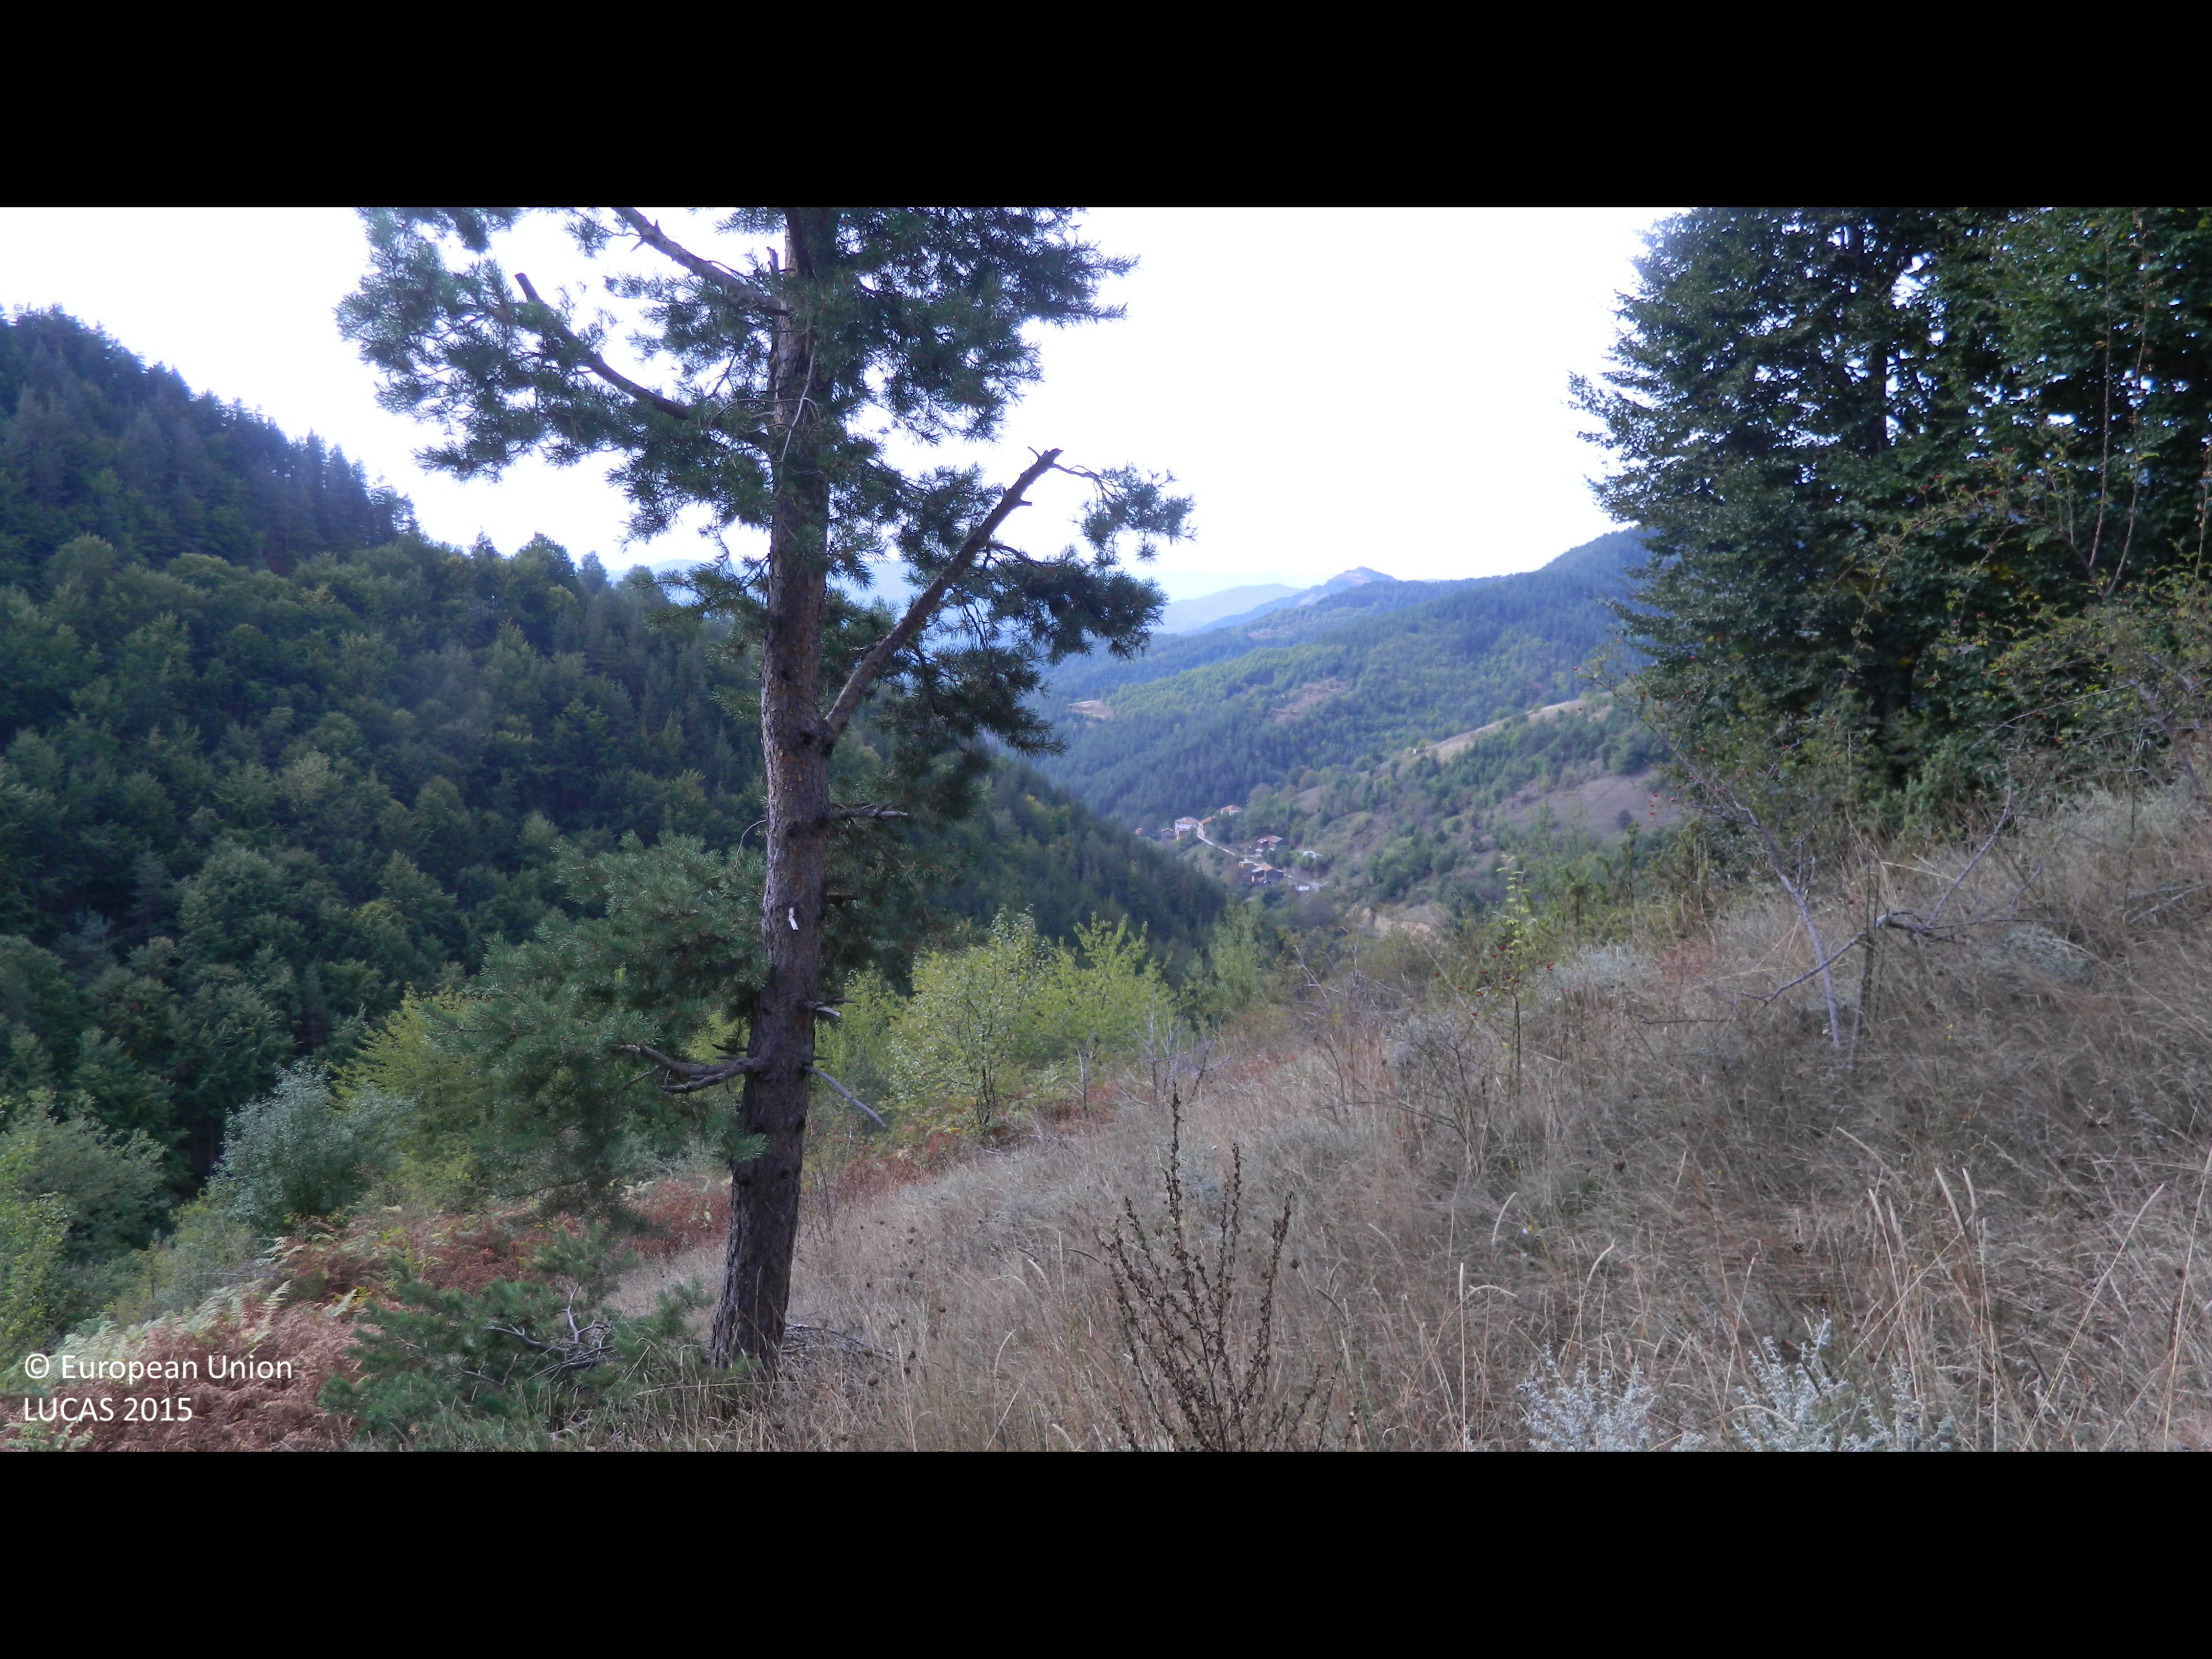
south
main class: Shrubland
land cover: Shrubland with sparse tree cover
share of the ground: > 75 %
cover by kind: herbaceous plants 80 %, shrubs 15 %, coniferous forest trees 5 %
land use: Semi-natural and natural areas not in use
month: October
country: BG
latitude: 41.6050
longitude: 24.8656
